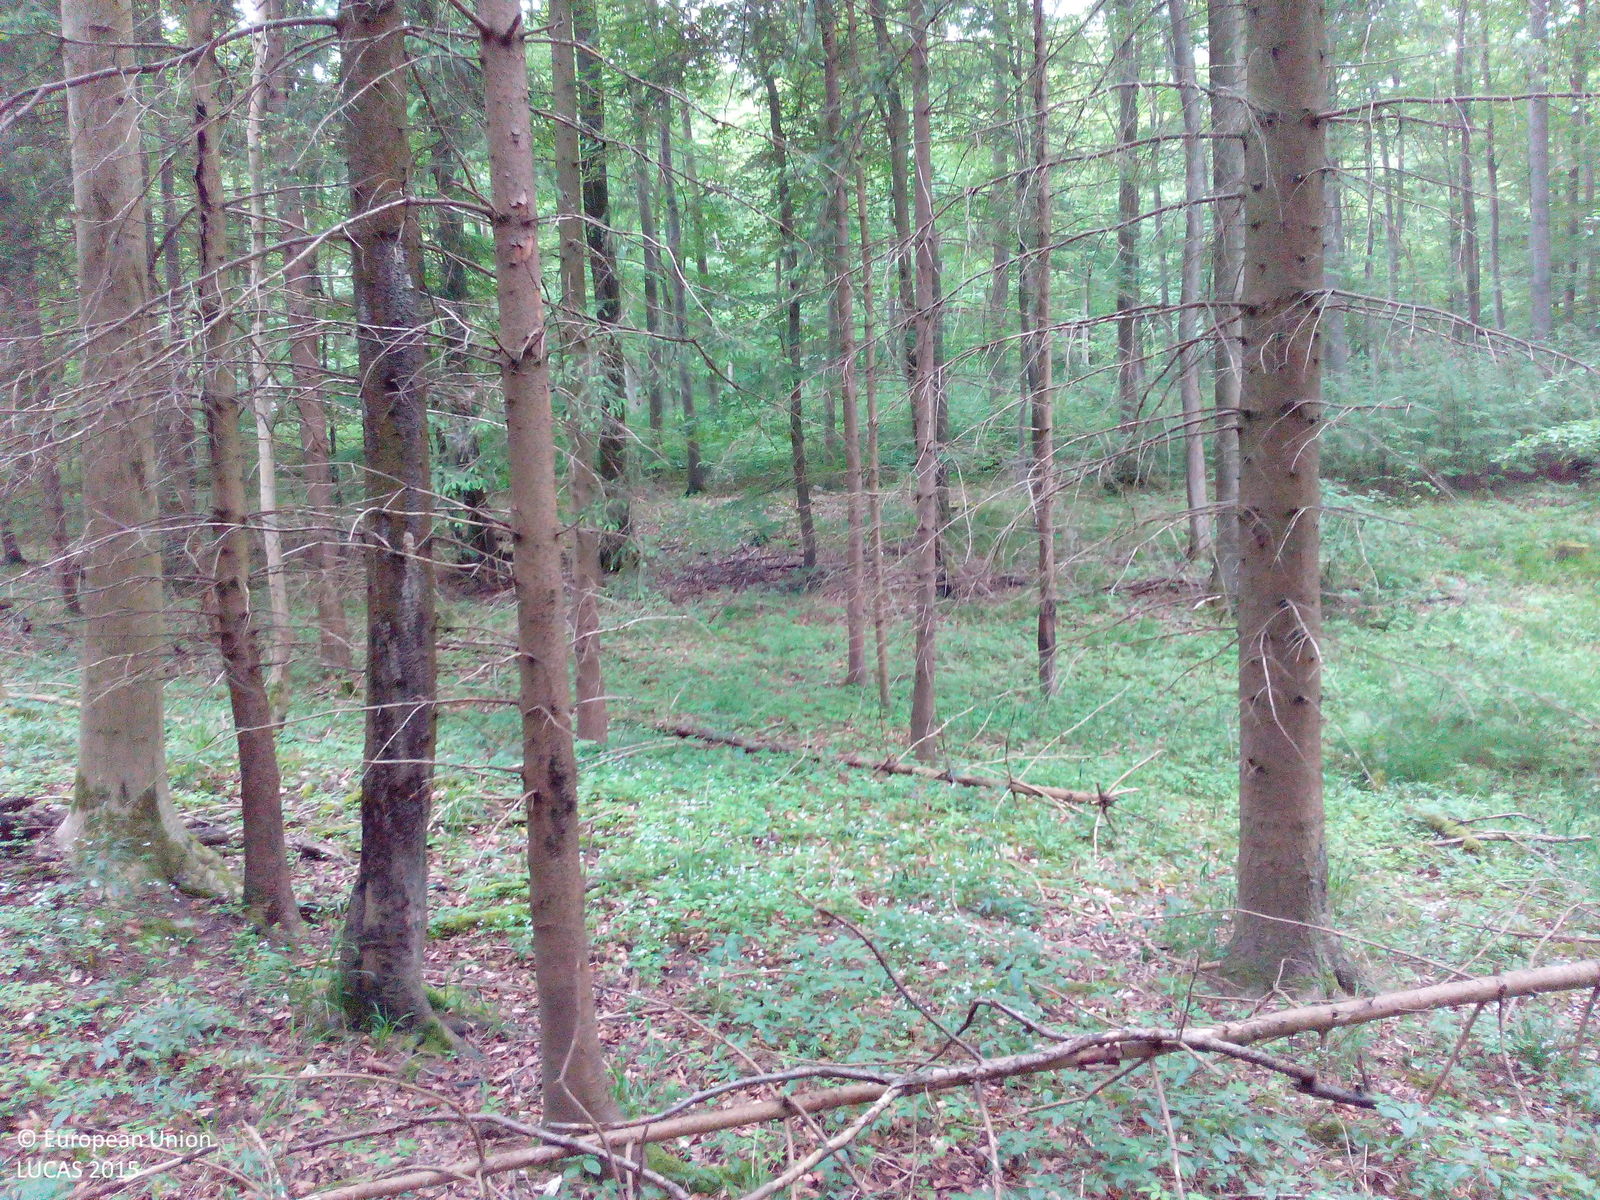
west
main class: Woodland
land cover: Spruce dominated coniferous woodland
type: hemiboreal forest and nemoral coniferous forest and mixed broadleaved-coniferous forest
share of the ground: > 75 %
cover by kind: coniferous forest trees 80 %, broadleaved forest trees 15 %, shrubs 5 %
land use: Forestry
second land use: Amenities, museums, leisure
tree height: > 5 m
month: May
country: DE
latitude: 51.9820
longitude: 9.8981
